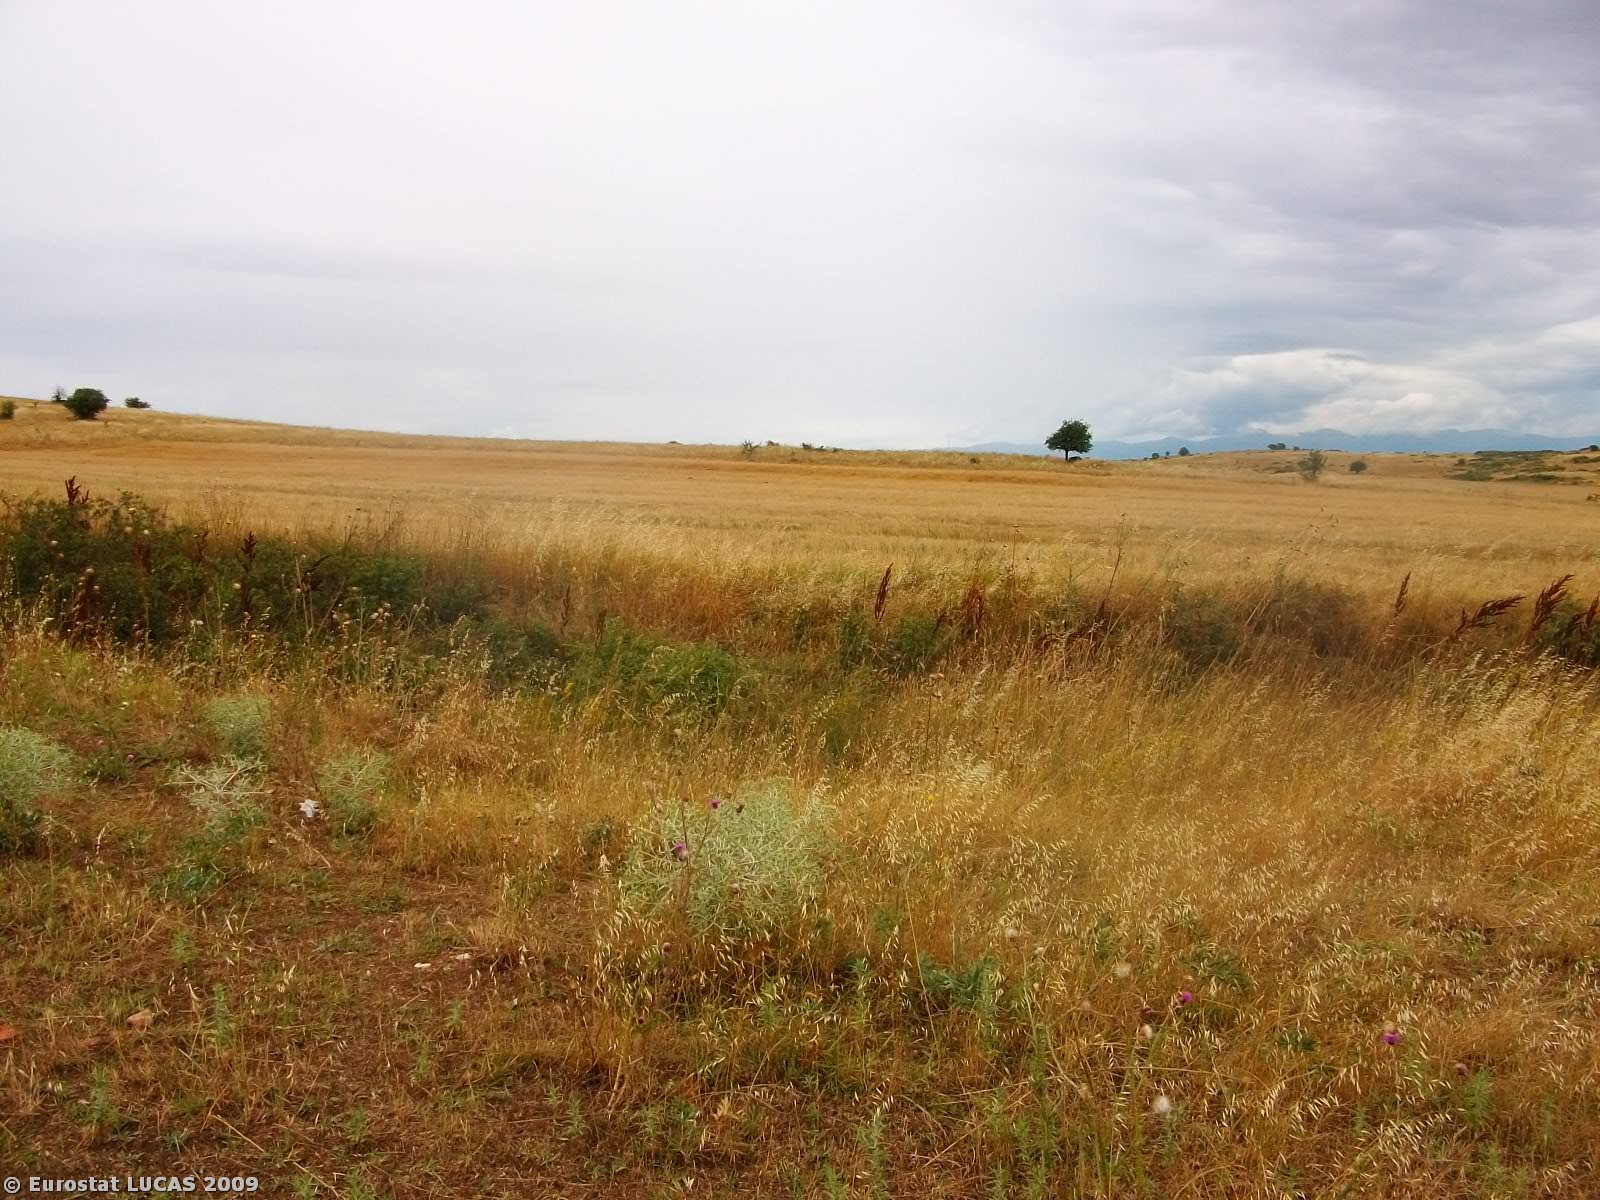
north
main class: Grassland
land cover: Grassland without tree/shrub cover
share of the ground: > 75 %
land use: Unused
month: June
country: GR
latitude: 41.0083
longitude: 22.7192
